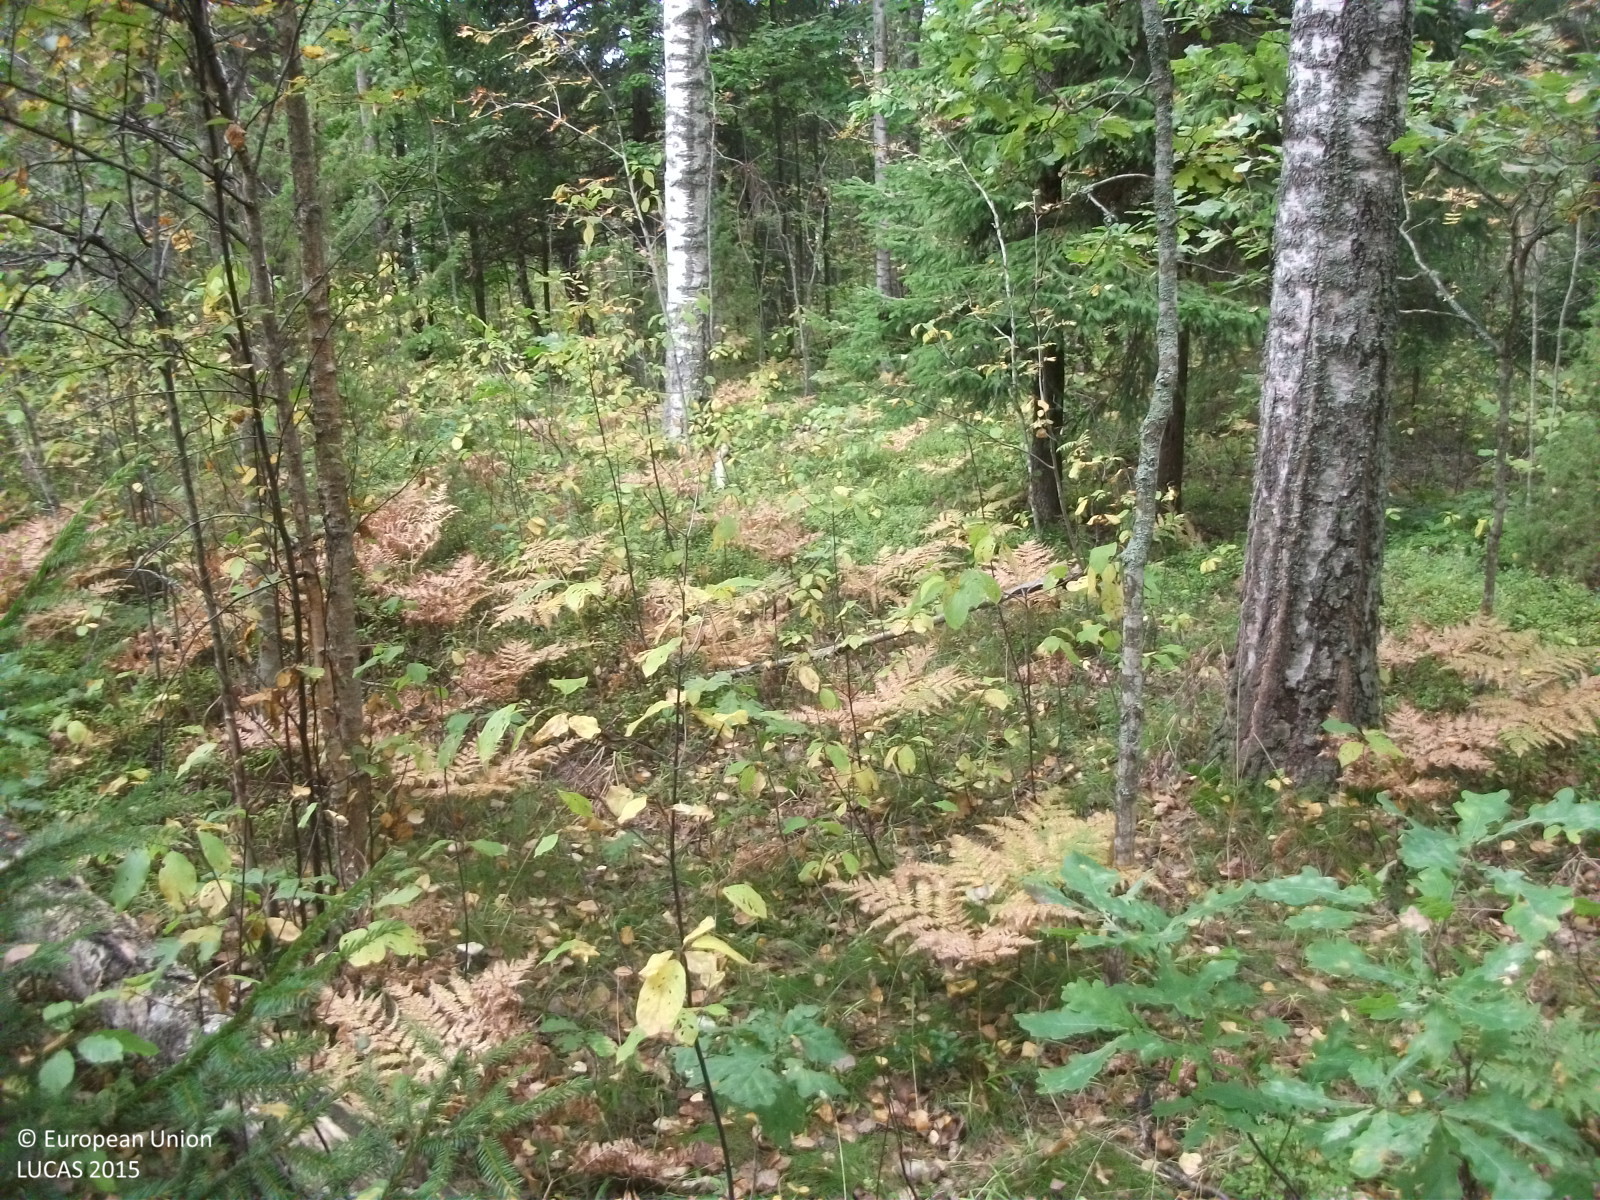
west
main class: Woodland
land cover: Broadleaved woodland
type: non-riverine alder, birch or aspen forest
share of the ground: > 75 %
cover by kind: broadleaved forest trees 85 %, coniferous forest trees 5 %, shrubs 5 %, herbaceous plants 5 %
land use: Forestry
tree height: > 5 m
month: September
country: LV
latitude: 57.8667
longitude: 24.5014
